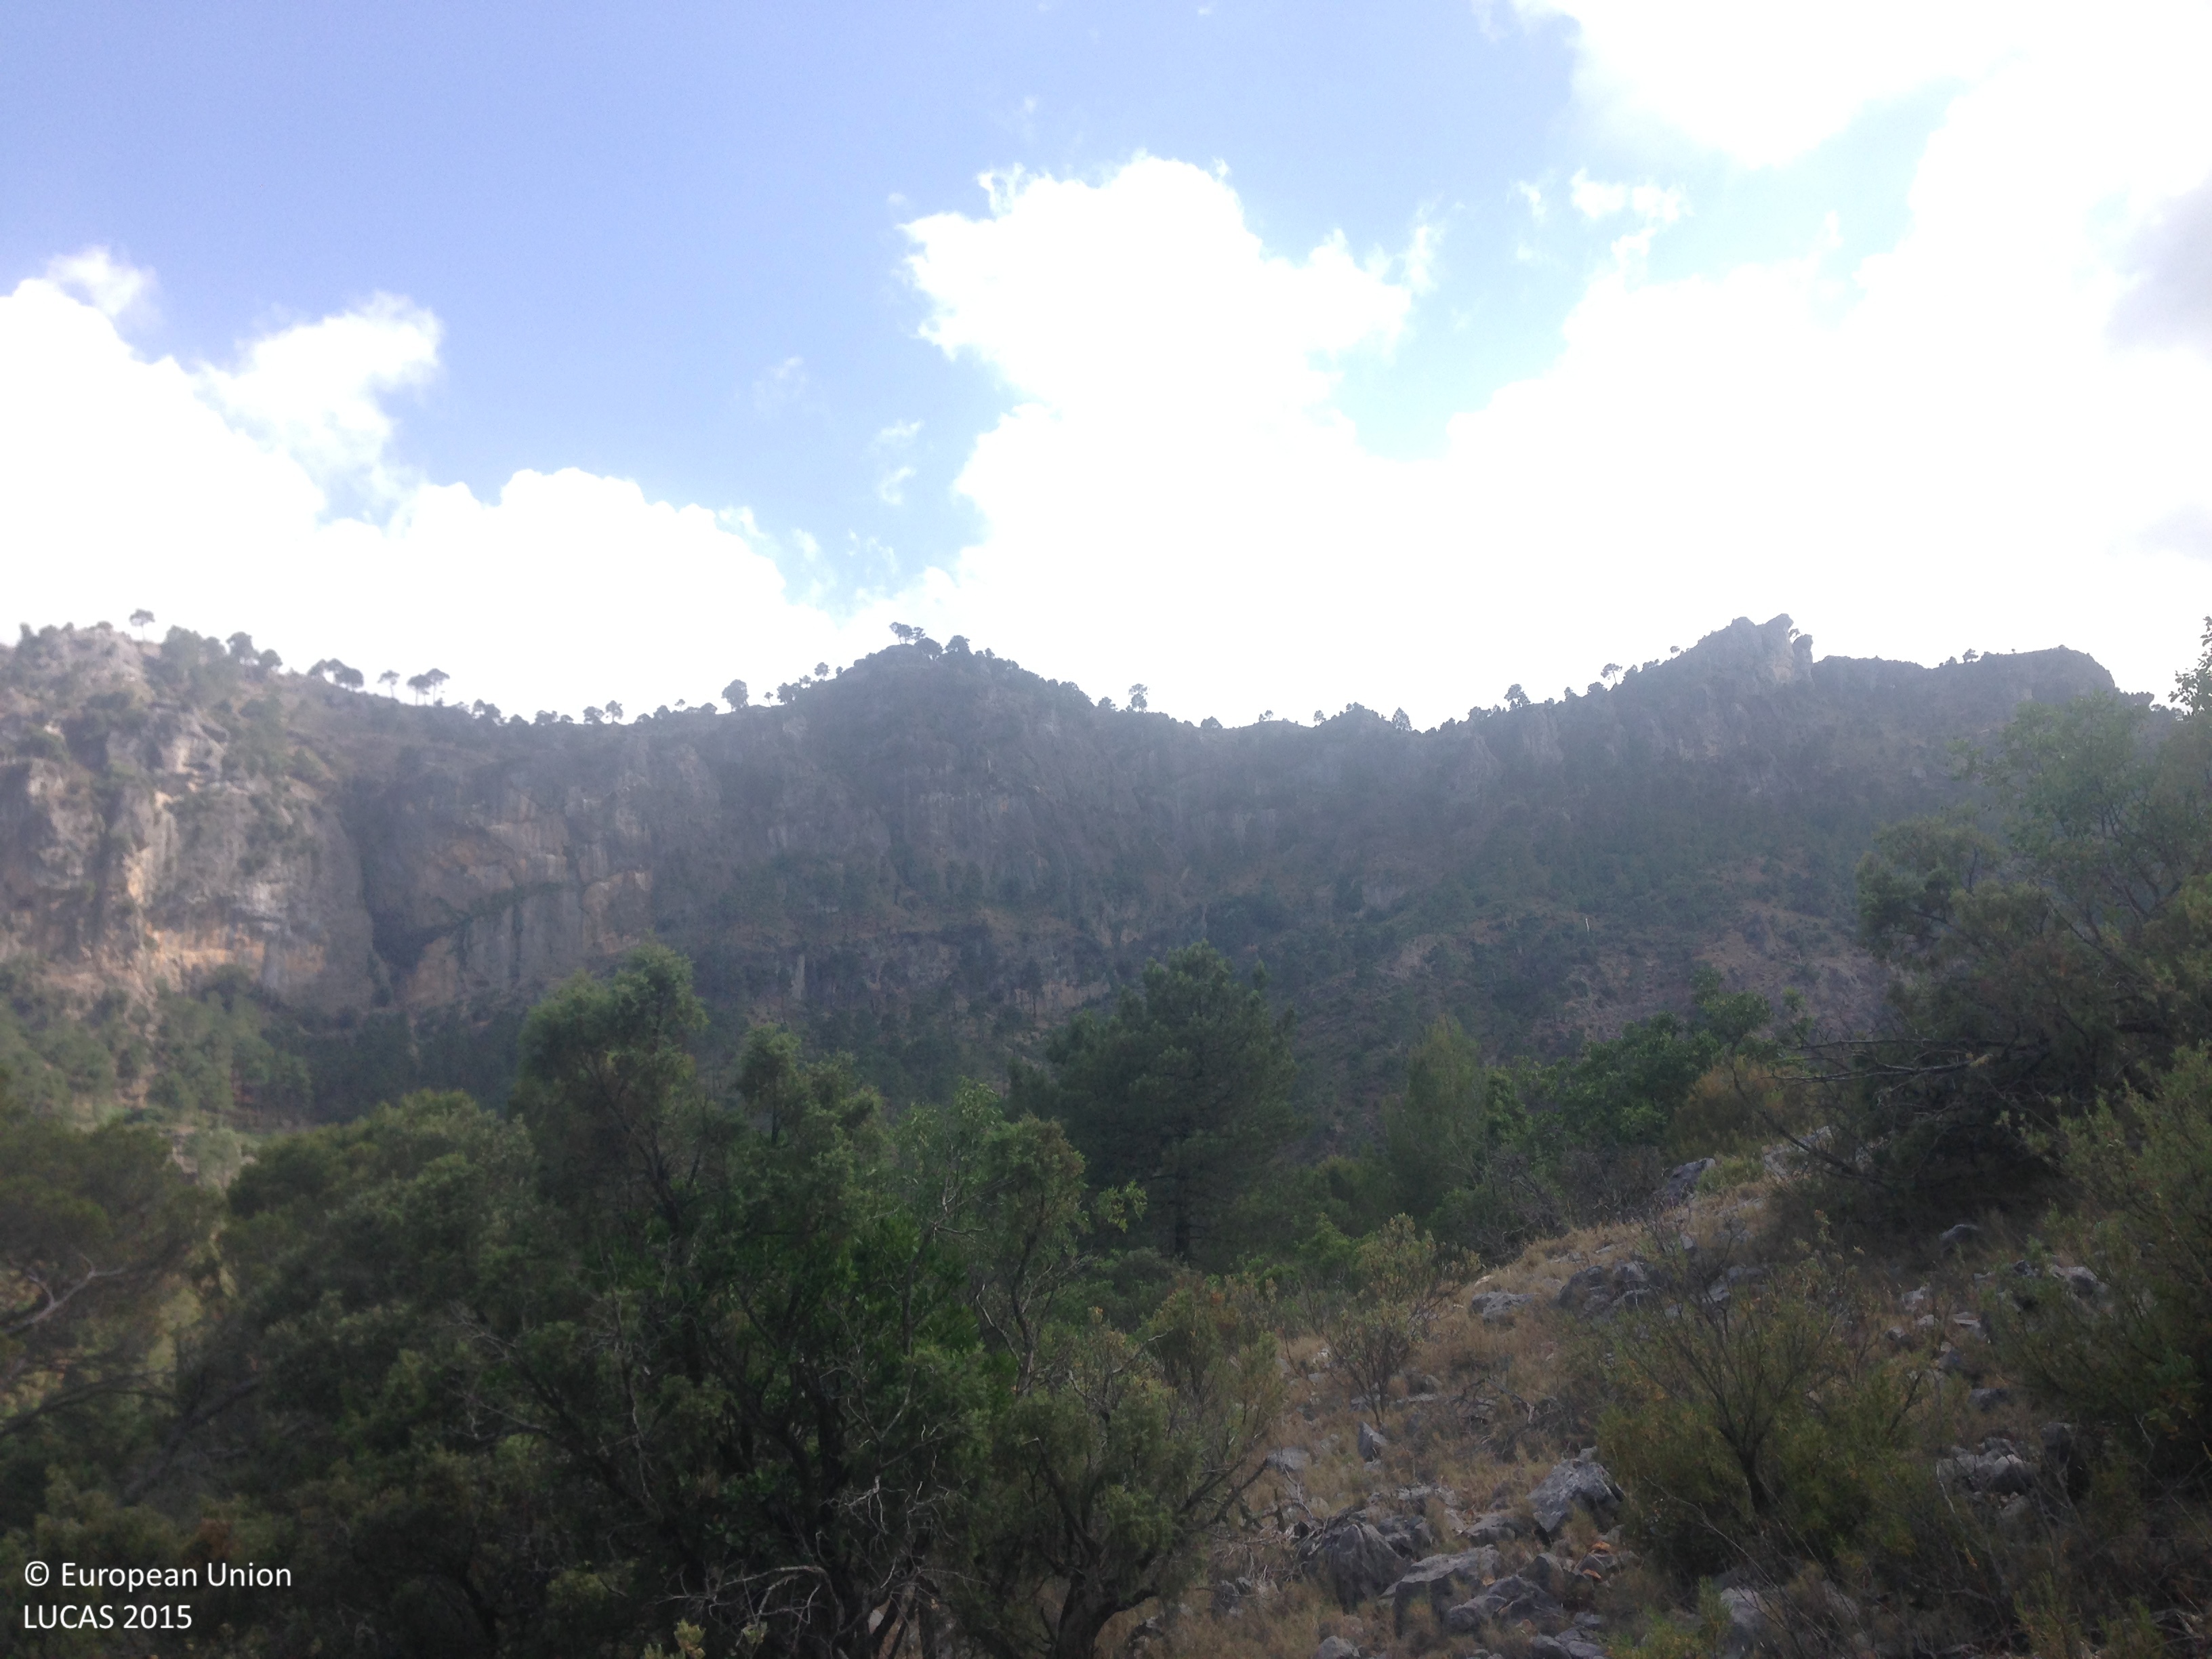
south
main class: Woodland
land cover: Pine dominated coniferous woodland
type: coniferous forest of the mediterranean region
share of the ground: 50 - 75 %
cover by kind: coniferous forest trees 60 %, shrubs 30 %, unconsolidated bare surface 10 %
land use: Forestry
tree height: > 5 m
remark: Clear cut
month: June
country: ES
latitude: 38.1718
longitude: -2.8620
